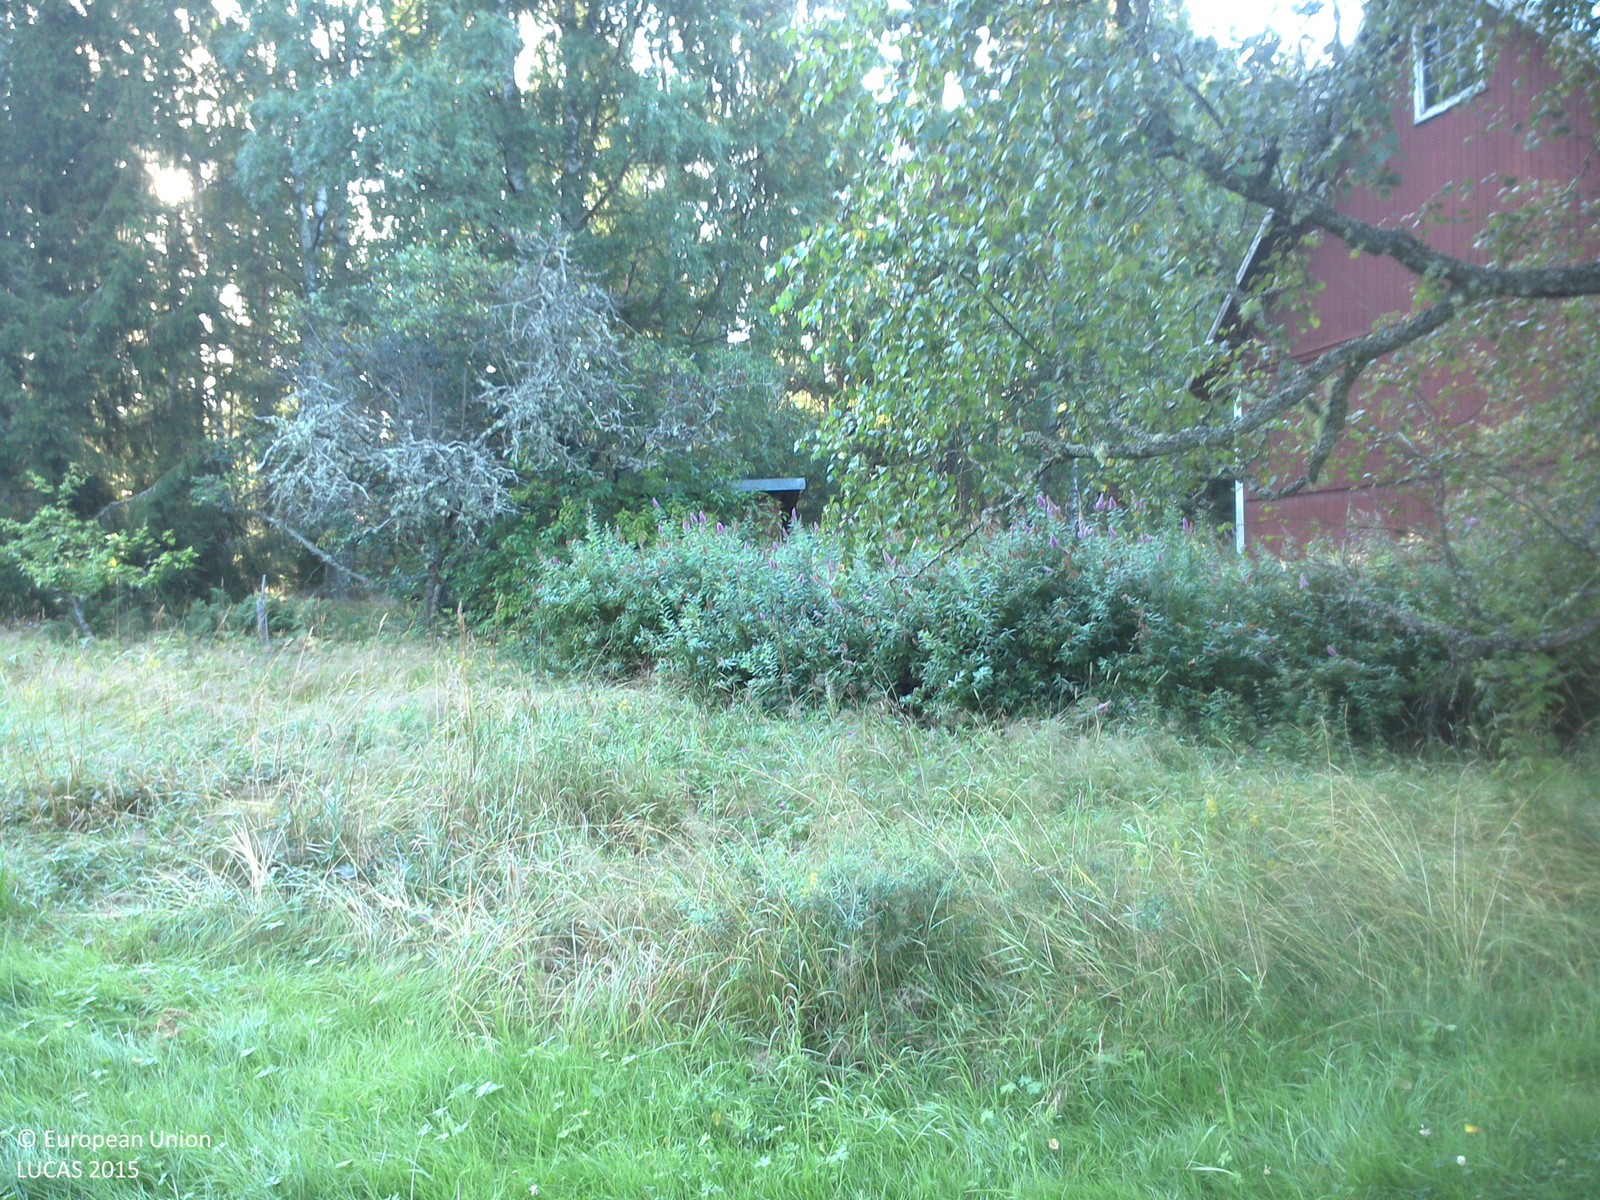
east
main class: Grassland
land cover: Grassland with sparse tree/shrub cover
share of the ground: > 75 %
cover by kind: herbaceous plants 95 %, broadleaved forest trees 5 %
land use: Residential
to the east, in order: Grassland with sparse tree/shrub cover; Broadleaved woodland; Pine dominated mixed woodland; Broadleaved woodland; Spruce dominated mixed woodland; Ditches and canals; Pine dominated mixed woodland
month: August
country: SE
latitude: 57.7935
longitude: 15.6655
